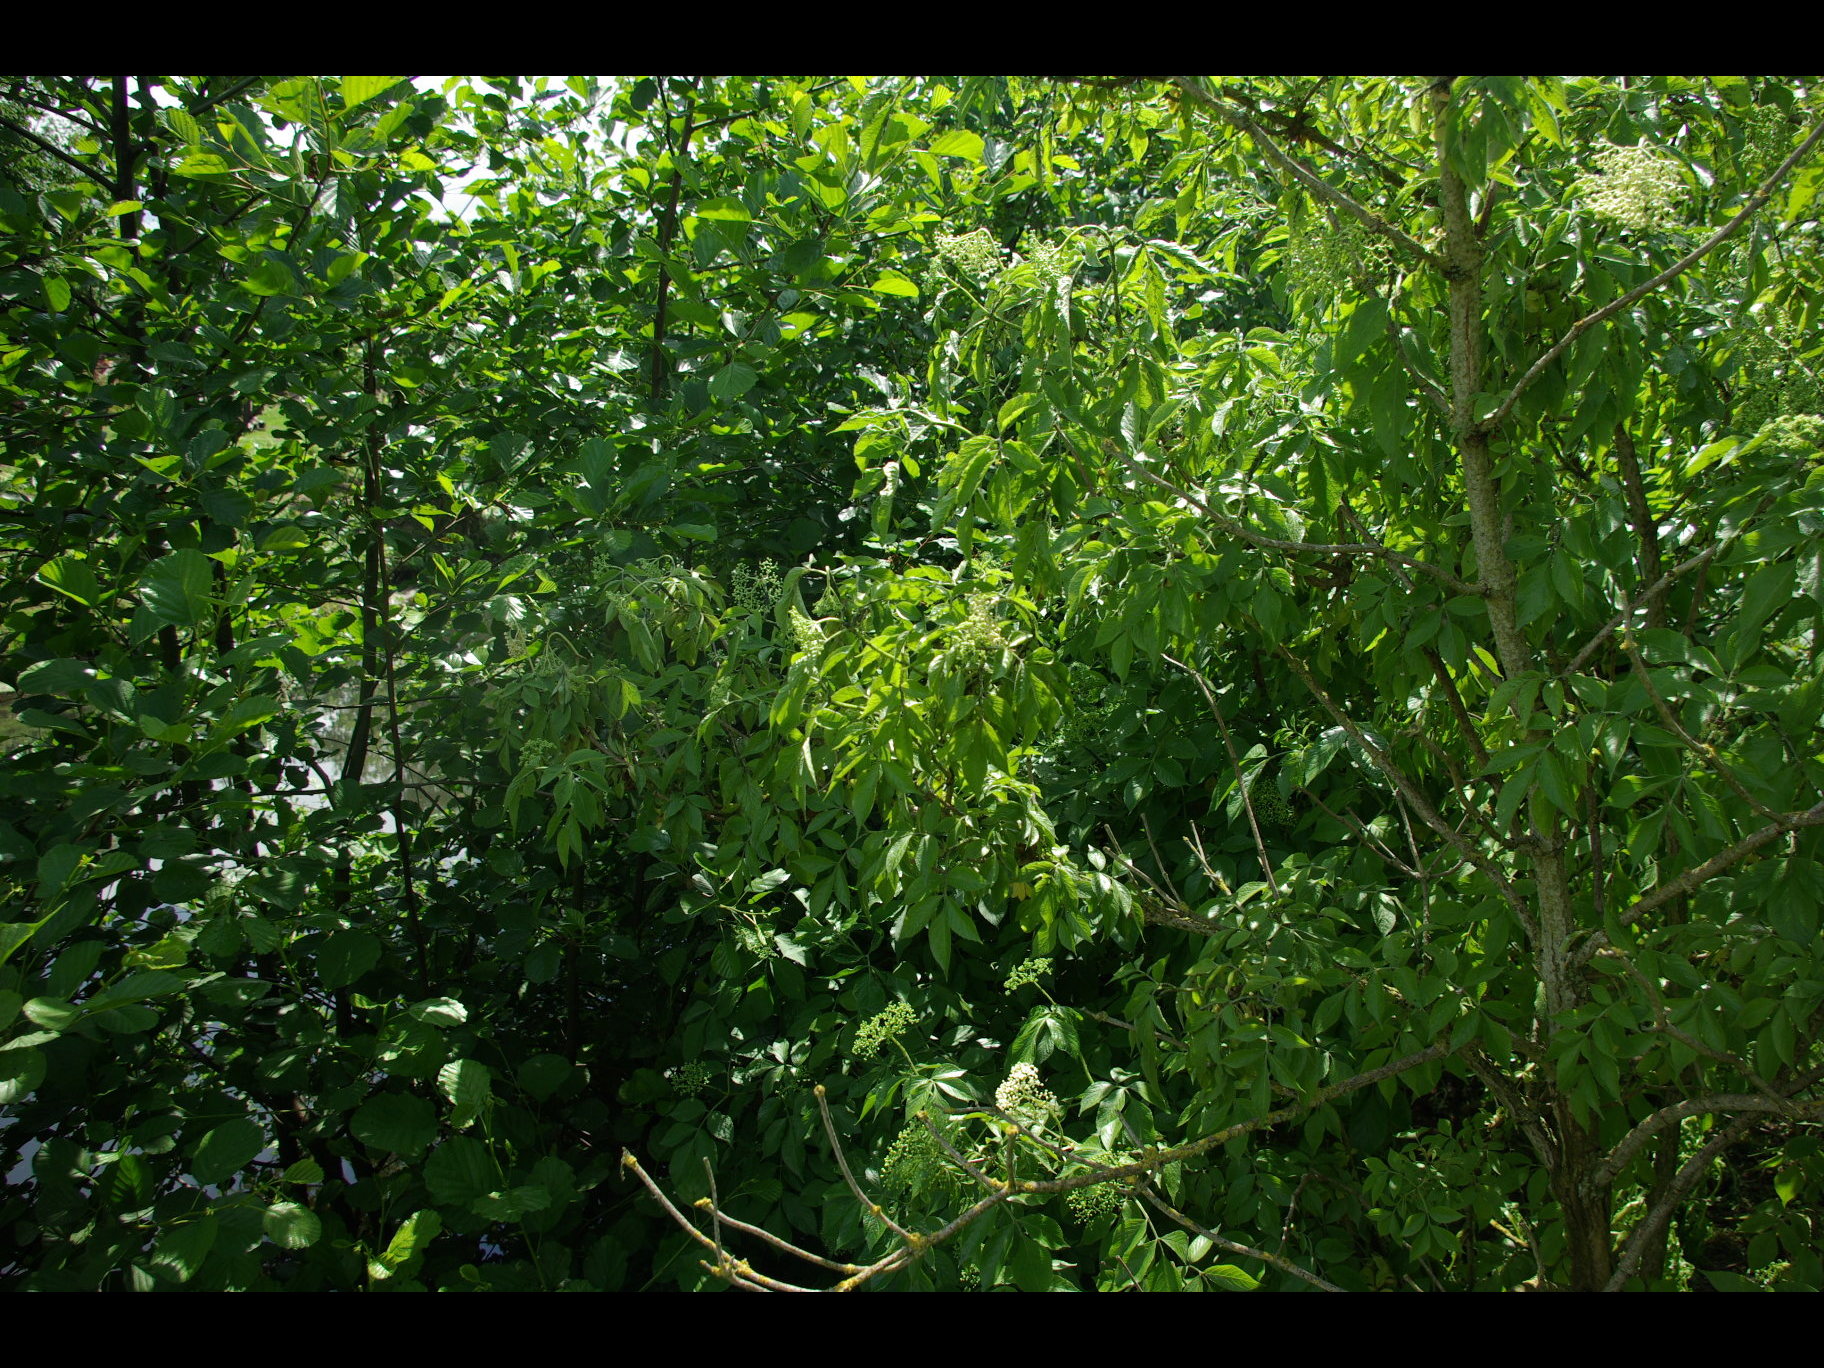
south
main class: Grassland
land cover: Grassland without tree/shrub cover
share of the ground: > 75 %
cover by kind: herbaceous plants 80 %, unconsolidated bare surface 20 %
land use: Agriculture (excluding fallow land and kitchen gardens)
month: June
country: DE
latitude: 54.0848
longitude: 9.8931
